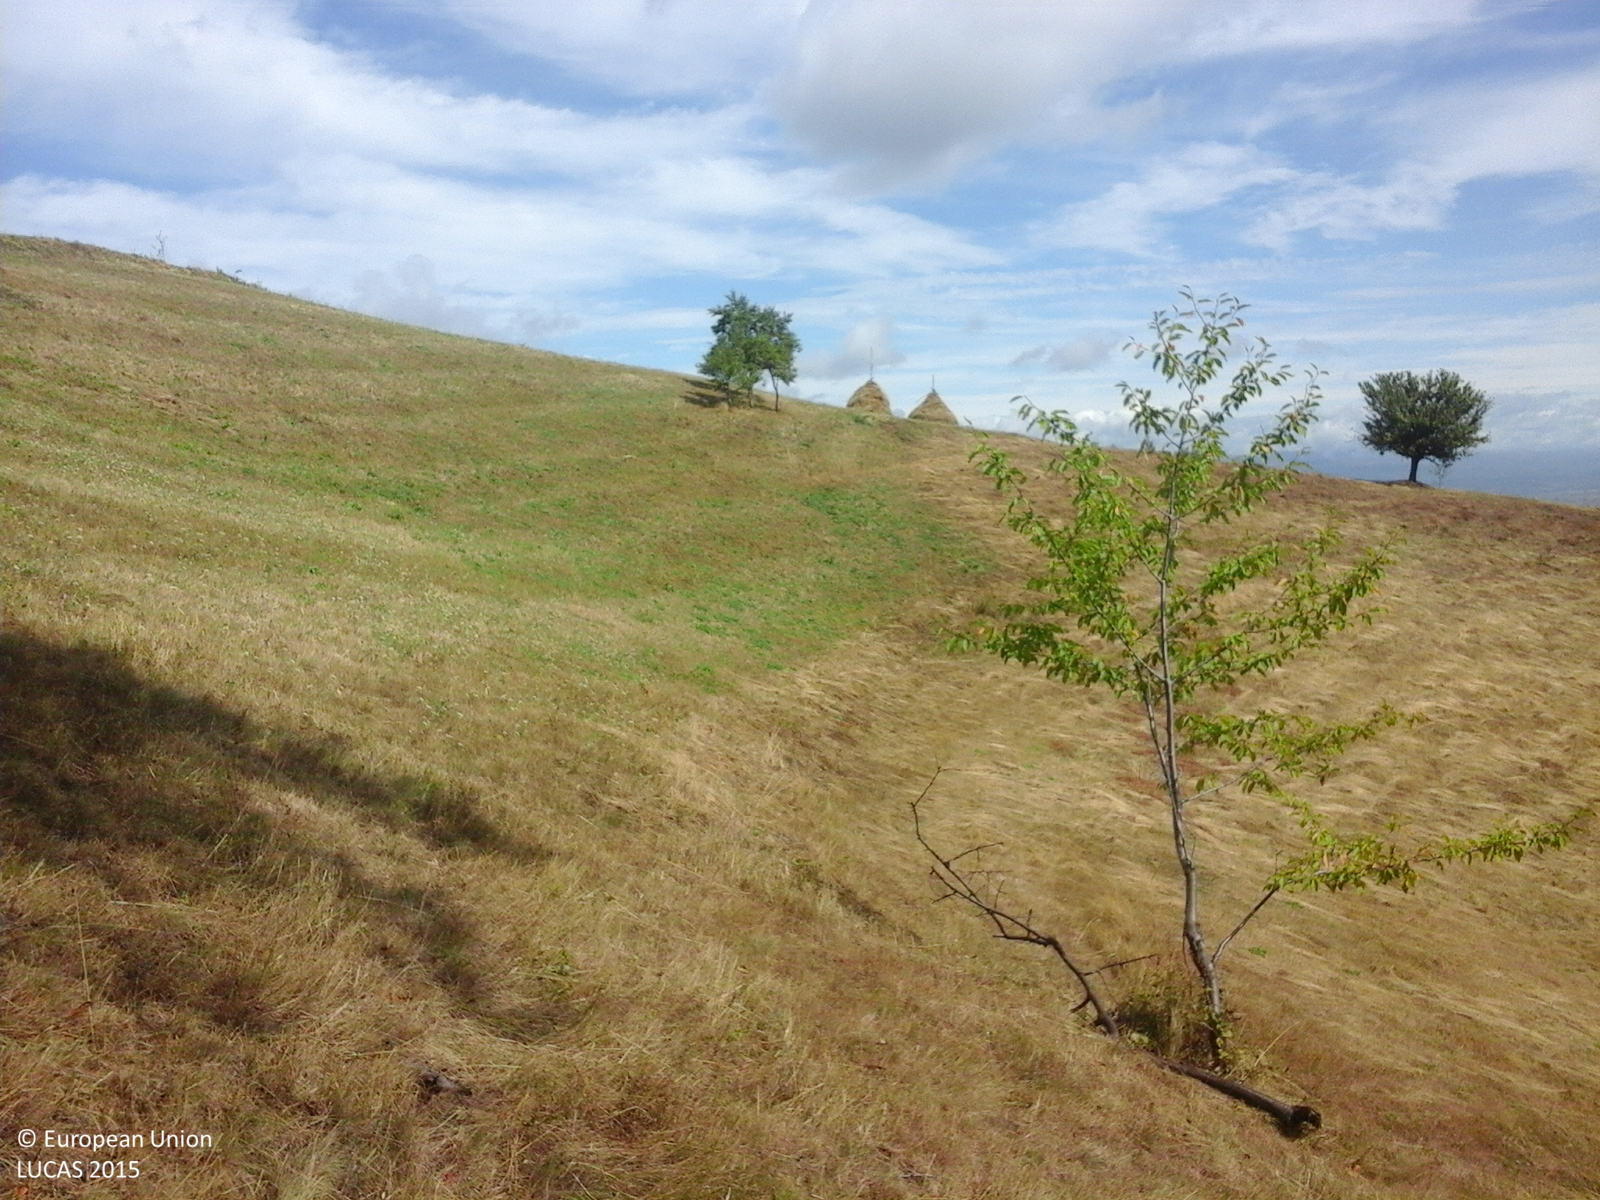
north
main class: Grassland
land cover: Grassland with sparse tree/shrub cover
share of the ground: > 75 %
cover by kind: herbaceous plants 85 %, shrubs 10 %, broadleaved forest trees 5 %
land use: Agriculture (excluding fallow land and kitchen gardens)
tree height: < 5 m
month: August
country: RO
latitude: 44.7950
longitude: 21.8768
